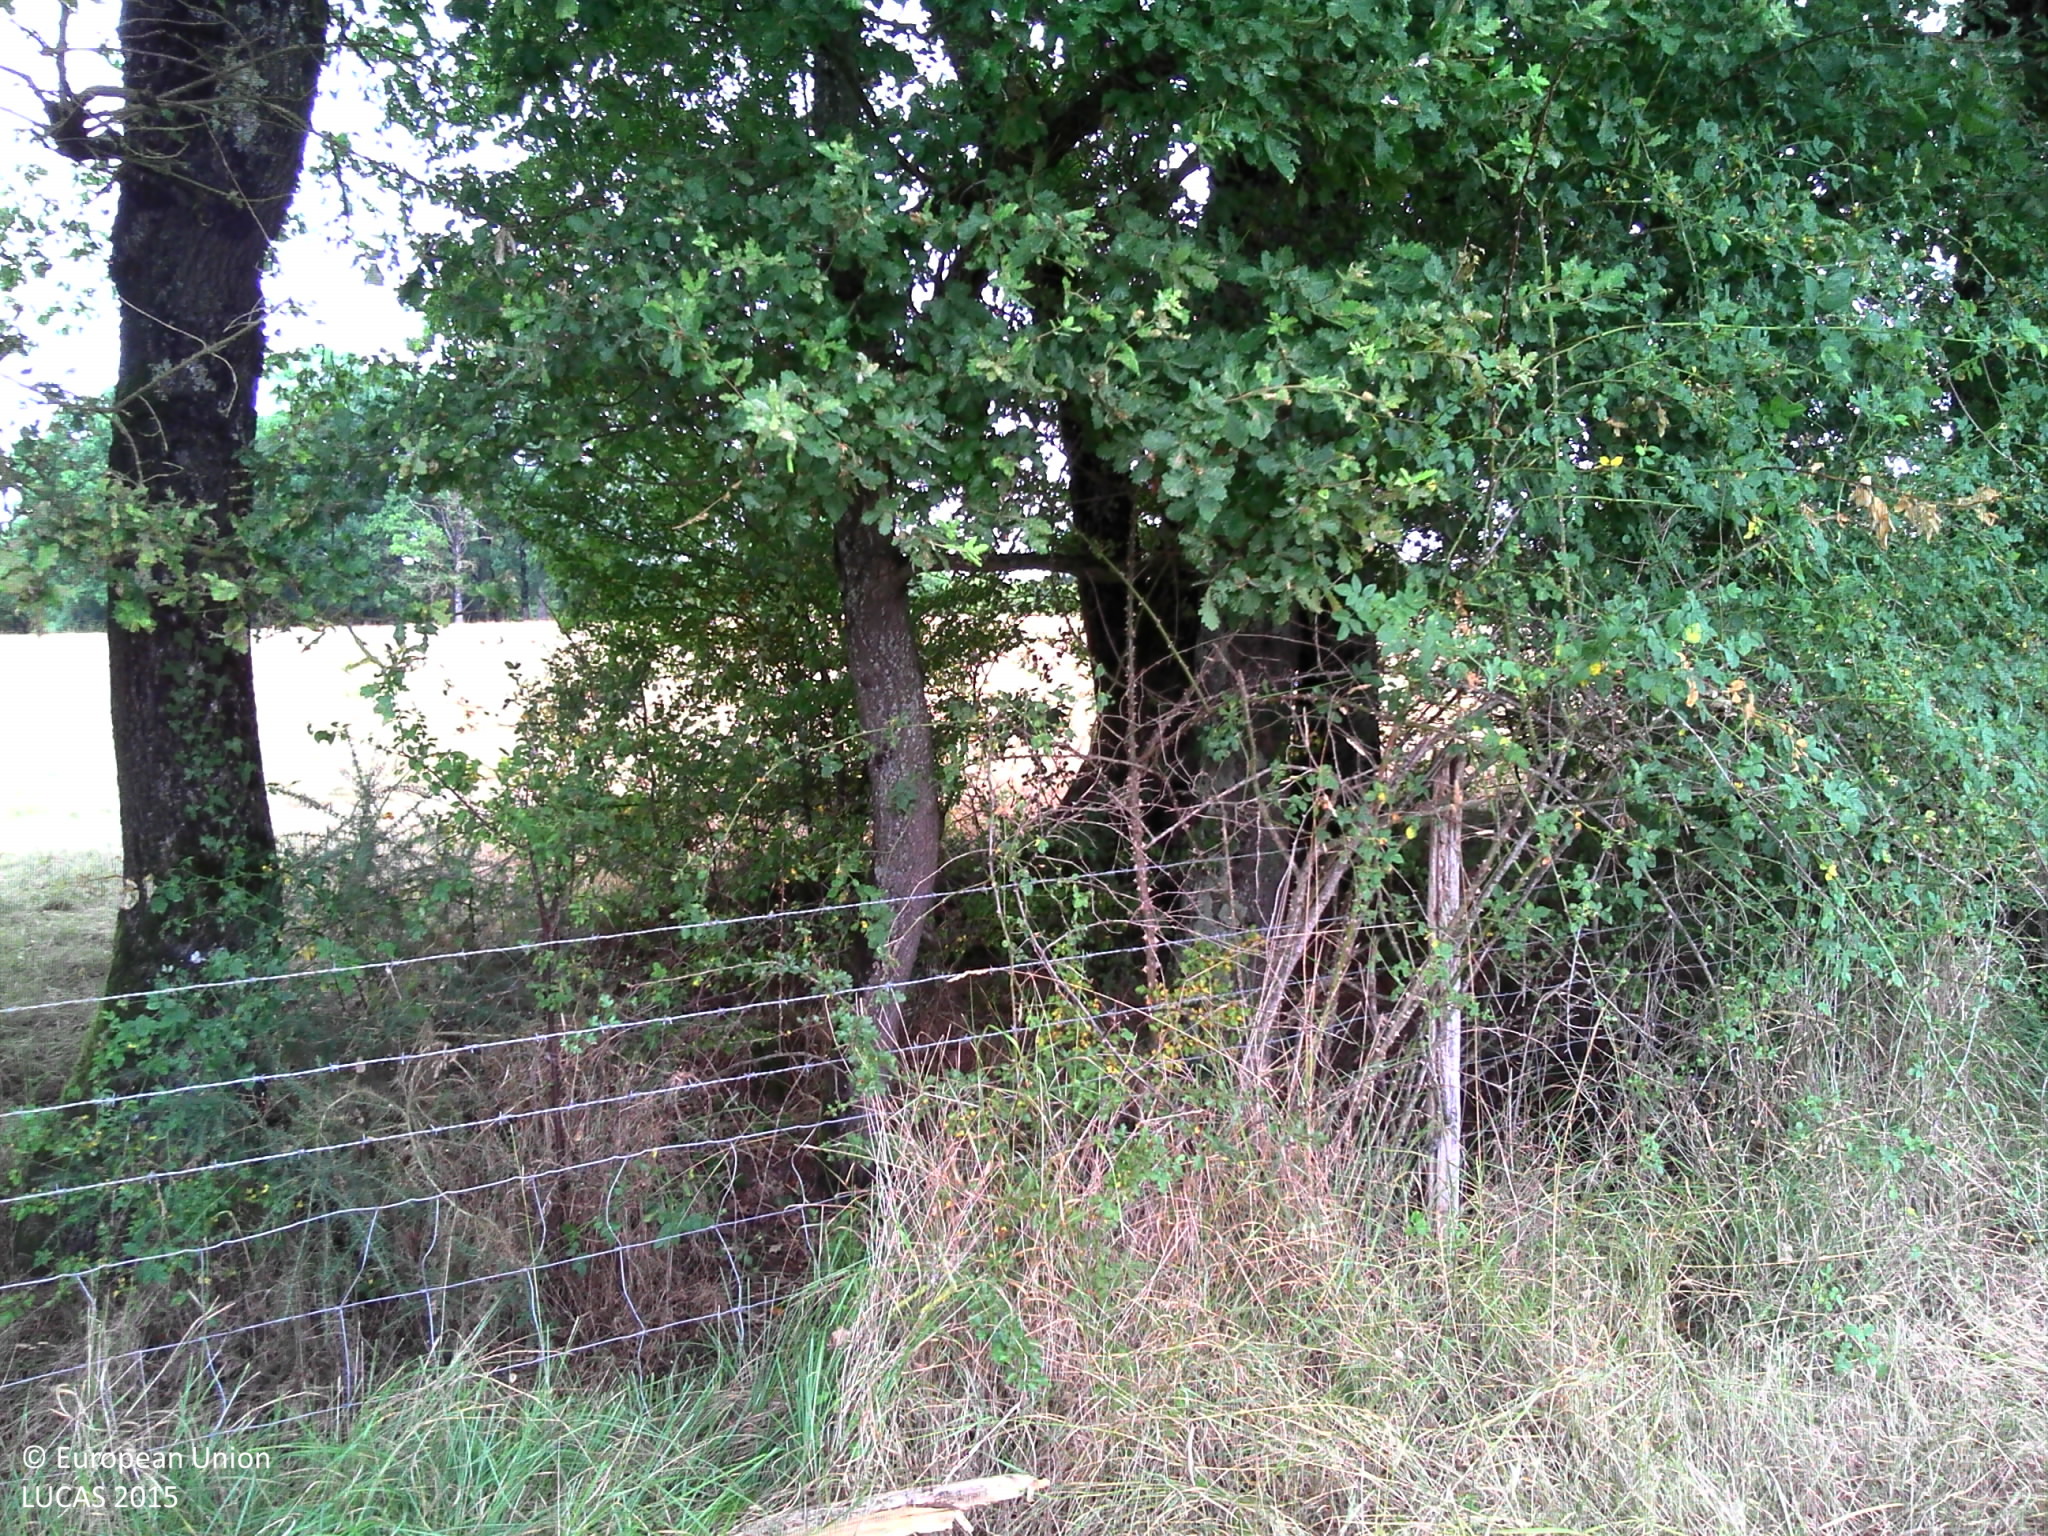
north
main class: Grassland
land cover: Grassland without tree/shrub cover
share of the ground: > 75 %
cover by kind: herbaceous plants 100 %
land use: Agriculture (excluding fallow land and kitchen gardens)
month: July
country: FR
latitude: 46.3322
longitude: 0.5658
